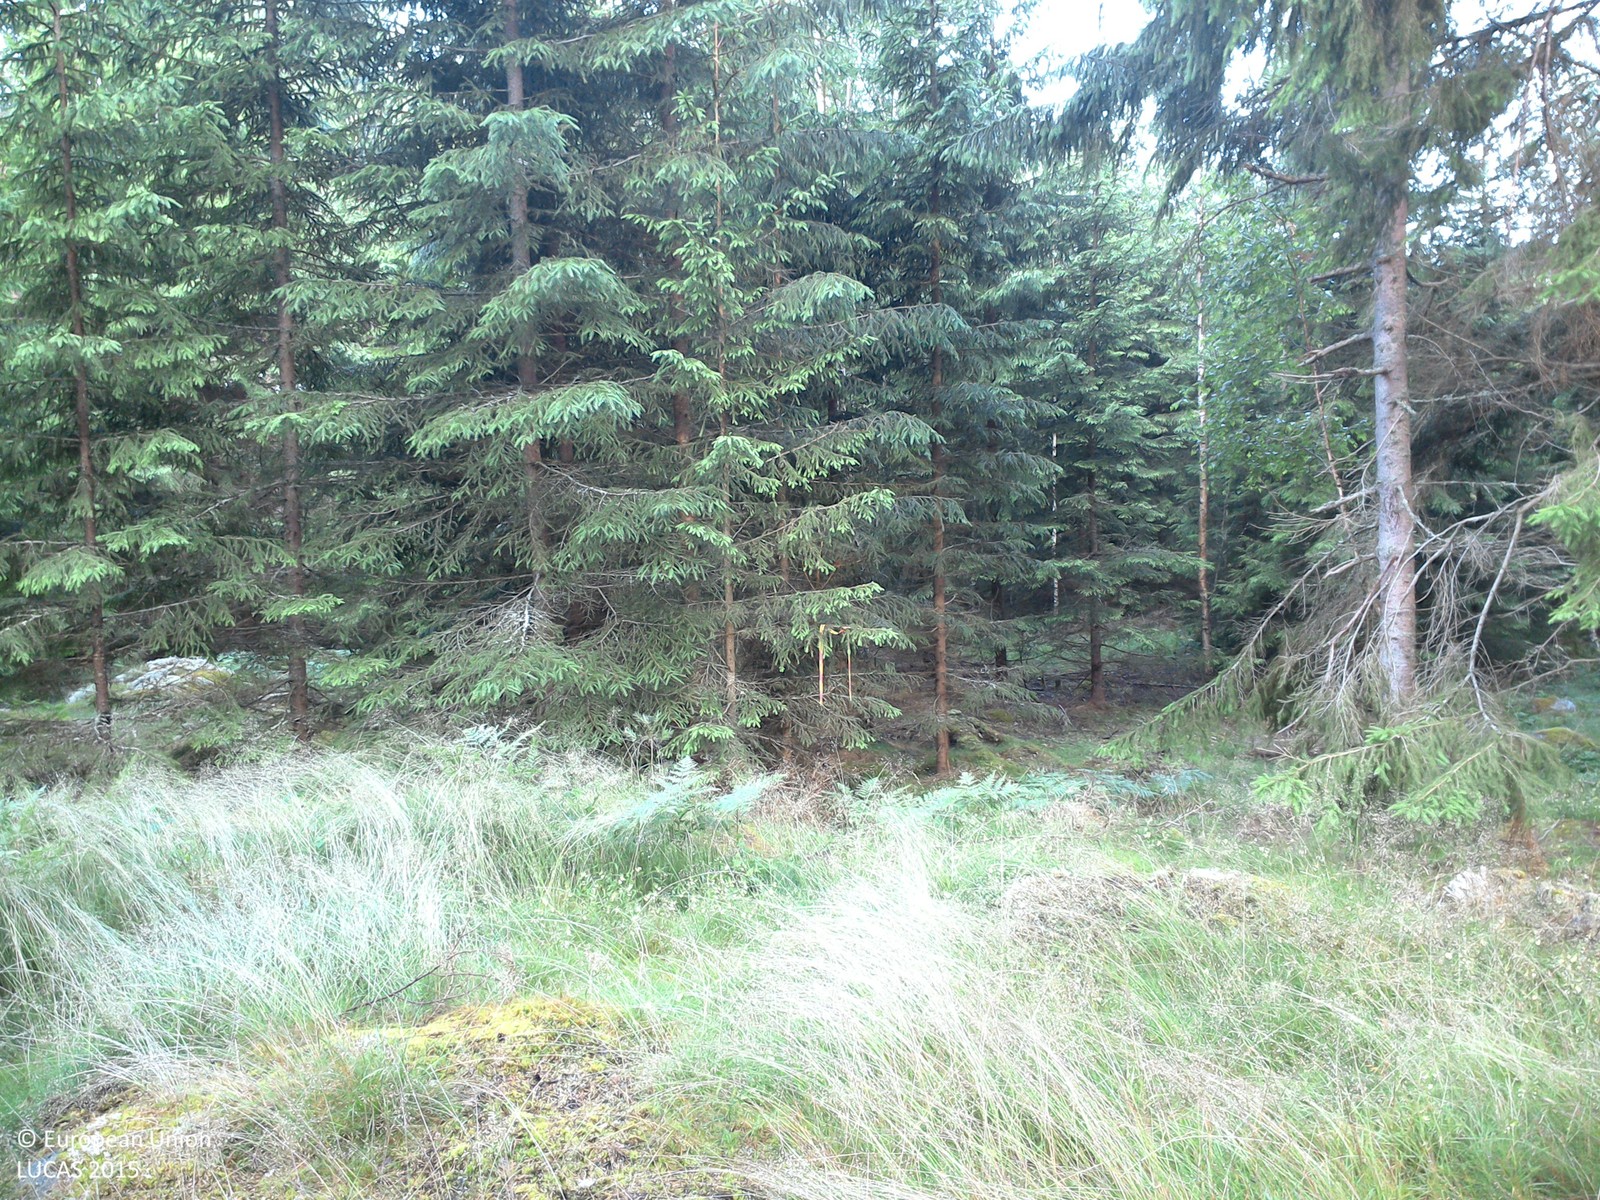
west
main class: Woodland
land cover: Pine dominated coniferous woodland
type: boreal forest
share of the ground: 25 - 50 %
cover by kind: coniferous forest trees 45 %, herbaceous plants 35 %, lichens and mosses 20 %
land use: Forestry
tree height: > 5 m
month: July
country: SE
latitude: 58.2711
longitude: 14.9894
